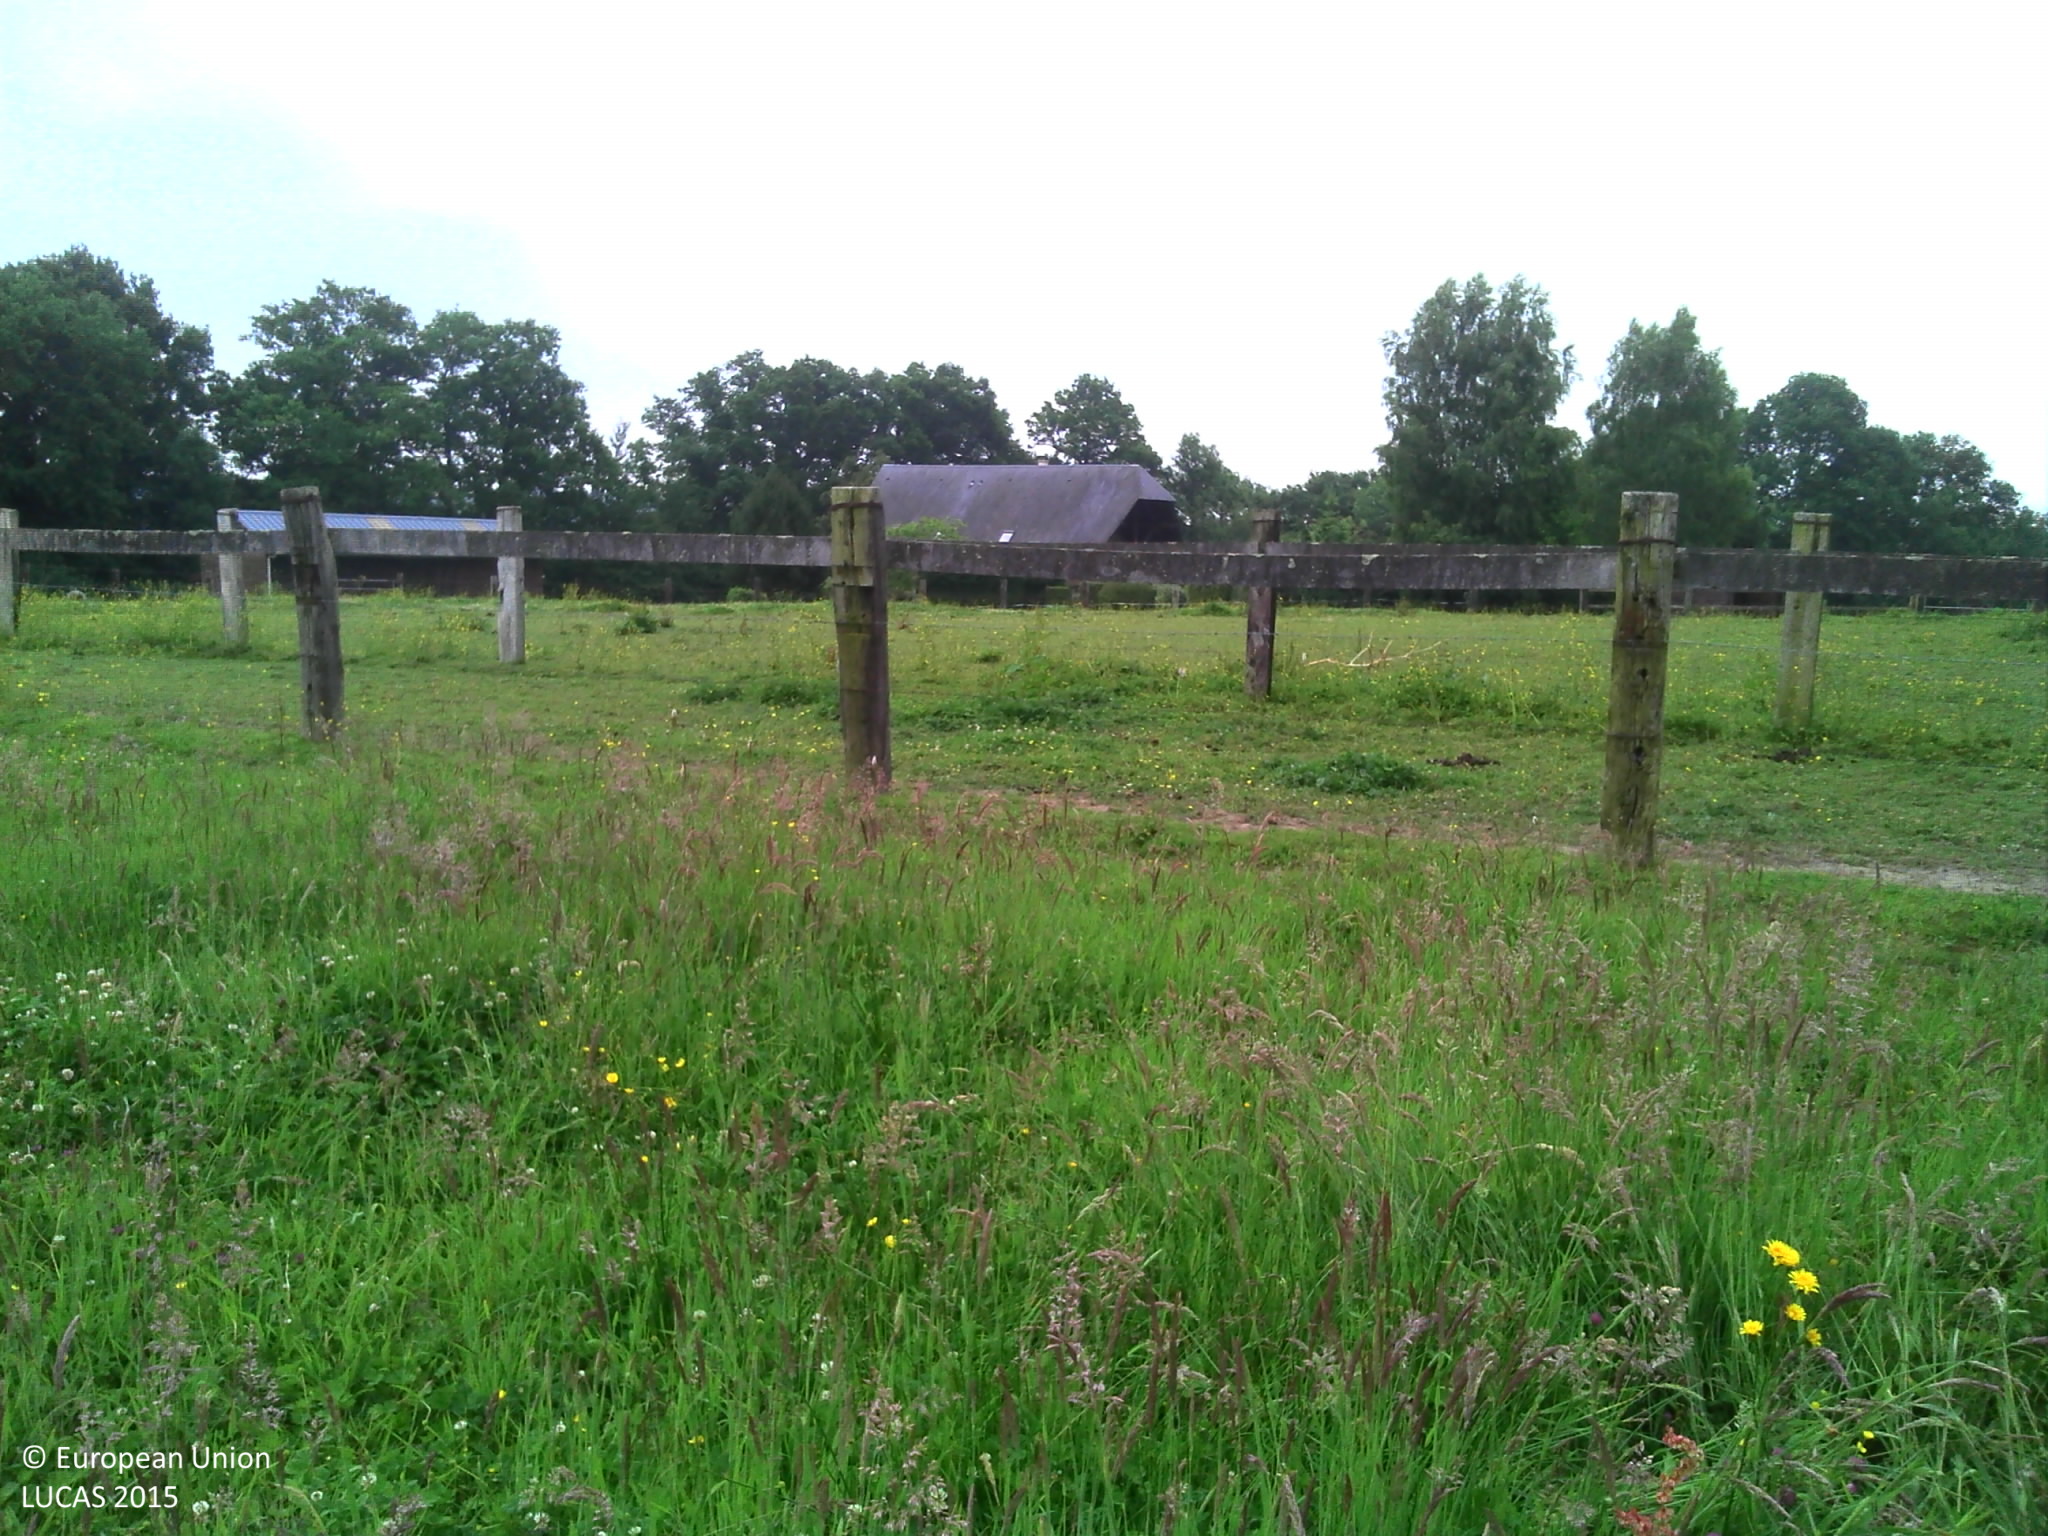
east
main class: Grassland
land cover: Grassland without tree/shrub cover
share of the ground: > 75 %
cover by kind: herbaceous plants 100 %
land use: Agriculture (excluding fallow land and kitchen gardens)
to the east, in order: Grassland without tree/shrub cover; Fences; Tracks; Fences; Grassland without tree/shrub cover; Artificial constructions in urban areas; Broadleaved woodland; Tracks; Broadleaved woodland; Grassland without tree/shrub cover; Fences; Broadleaved woodland; Tracks; Broadleaved woodland; Spontaneously vegetated surfaces; Grassland without tree/shrub cover
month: June
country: FR
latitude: 49.2347
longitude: -0.0157
